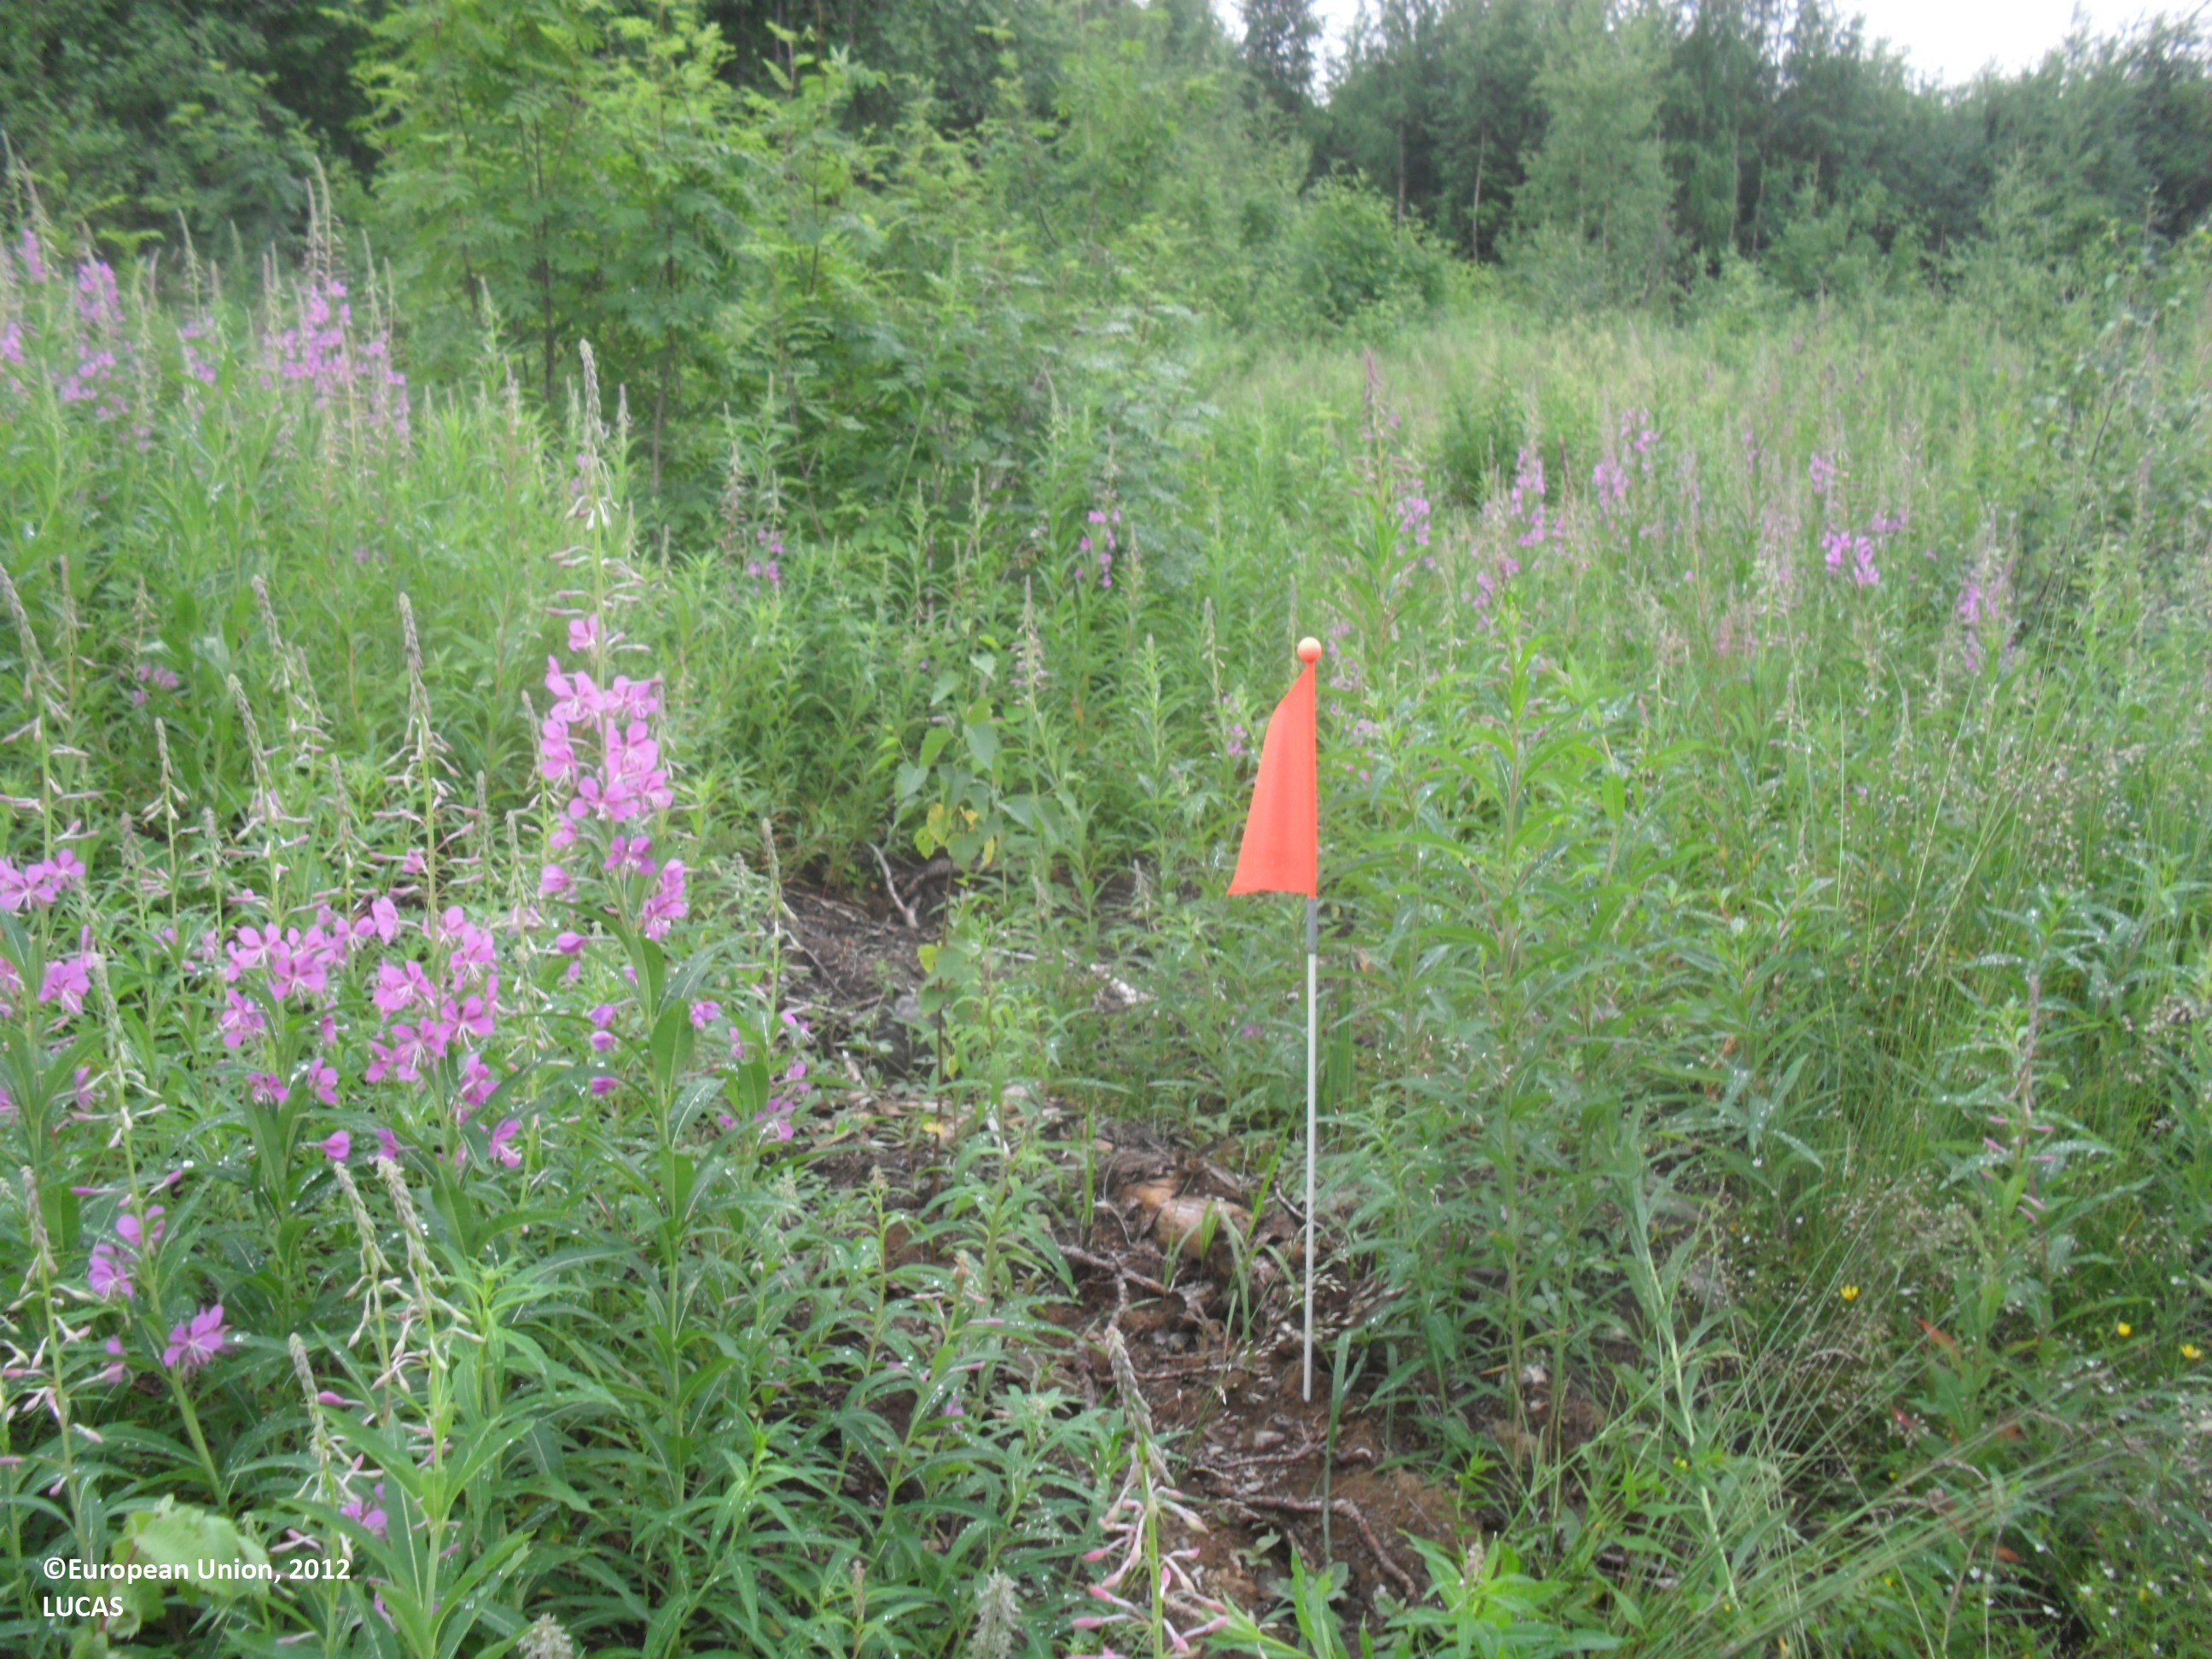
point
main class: Shrubland
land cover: Shrubland with sparse tree cover
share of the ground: 50 - 75 %
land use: Forestry
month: July
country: FI
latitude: 63.4352
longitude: 23.6743
